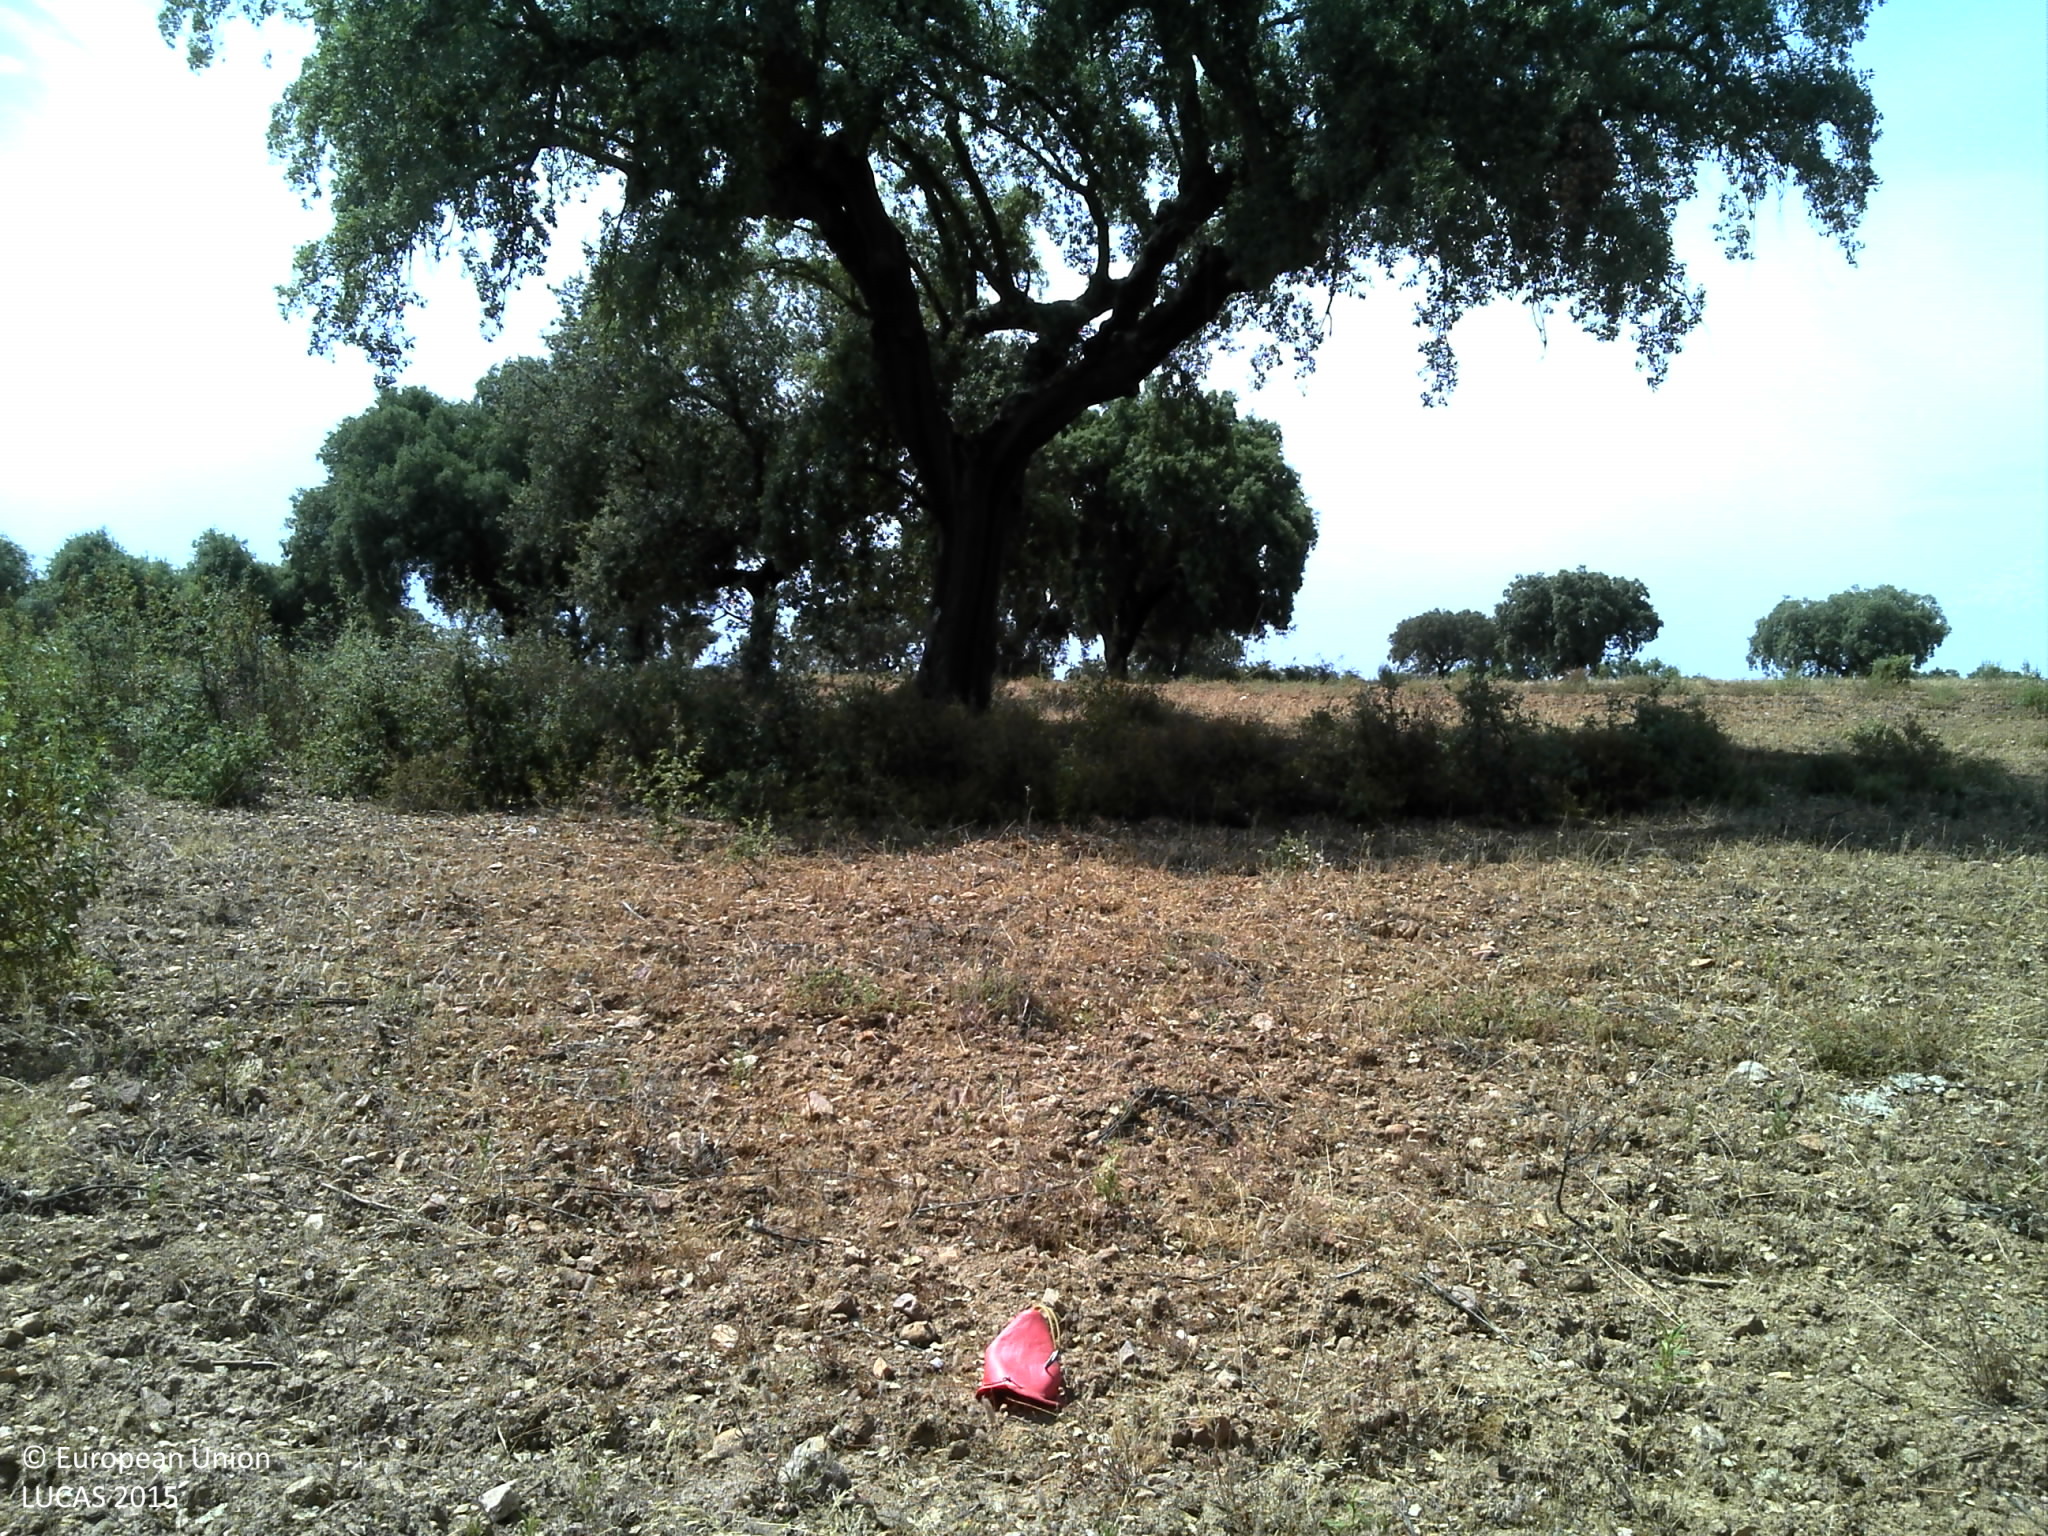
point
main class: Woodland
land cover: Broadleaved woodland
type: broadleaved evergreen forest
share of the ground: 10 - 25 %
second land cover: Grassland without tree/shrub cover
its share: 10 - 25 %
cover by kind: unconsolidated bare surface 70 %, broadleaved forest trees 15 %, herbaceous plants 15 %
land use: Forestry
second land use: Agriculture (excluding fallow land and kitchen gardens)
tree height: > 5 m
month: June
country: PT
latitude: 38.6268
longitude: -7.6902
